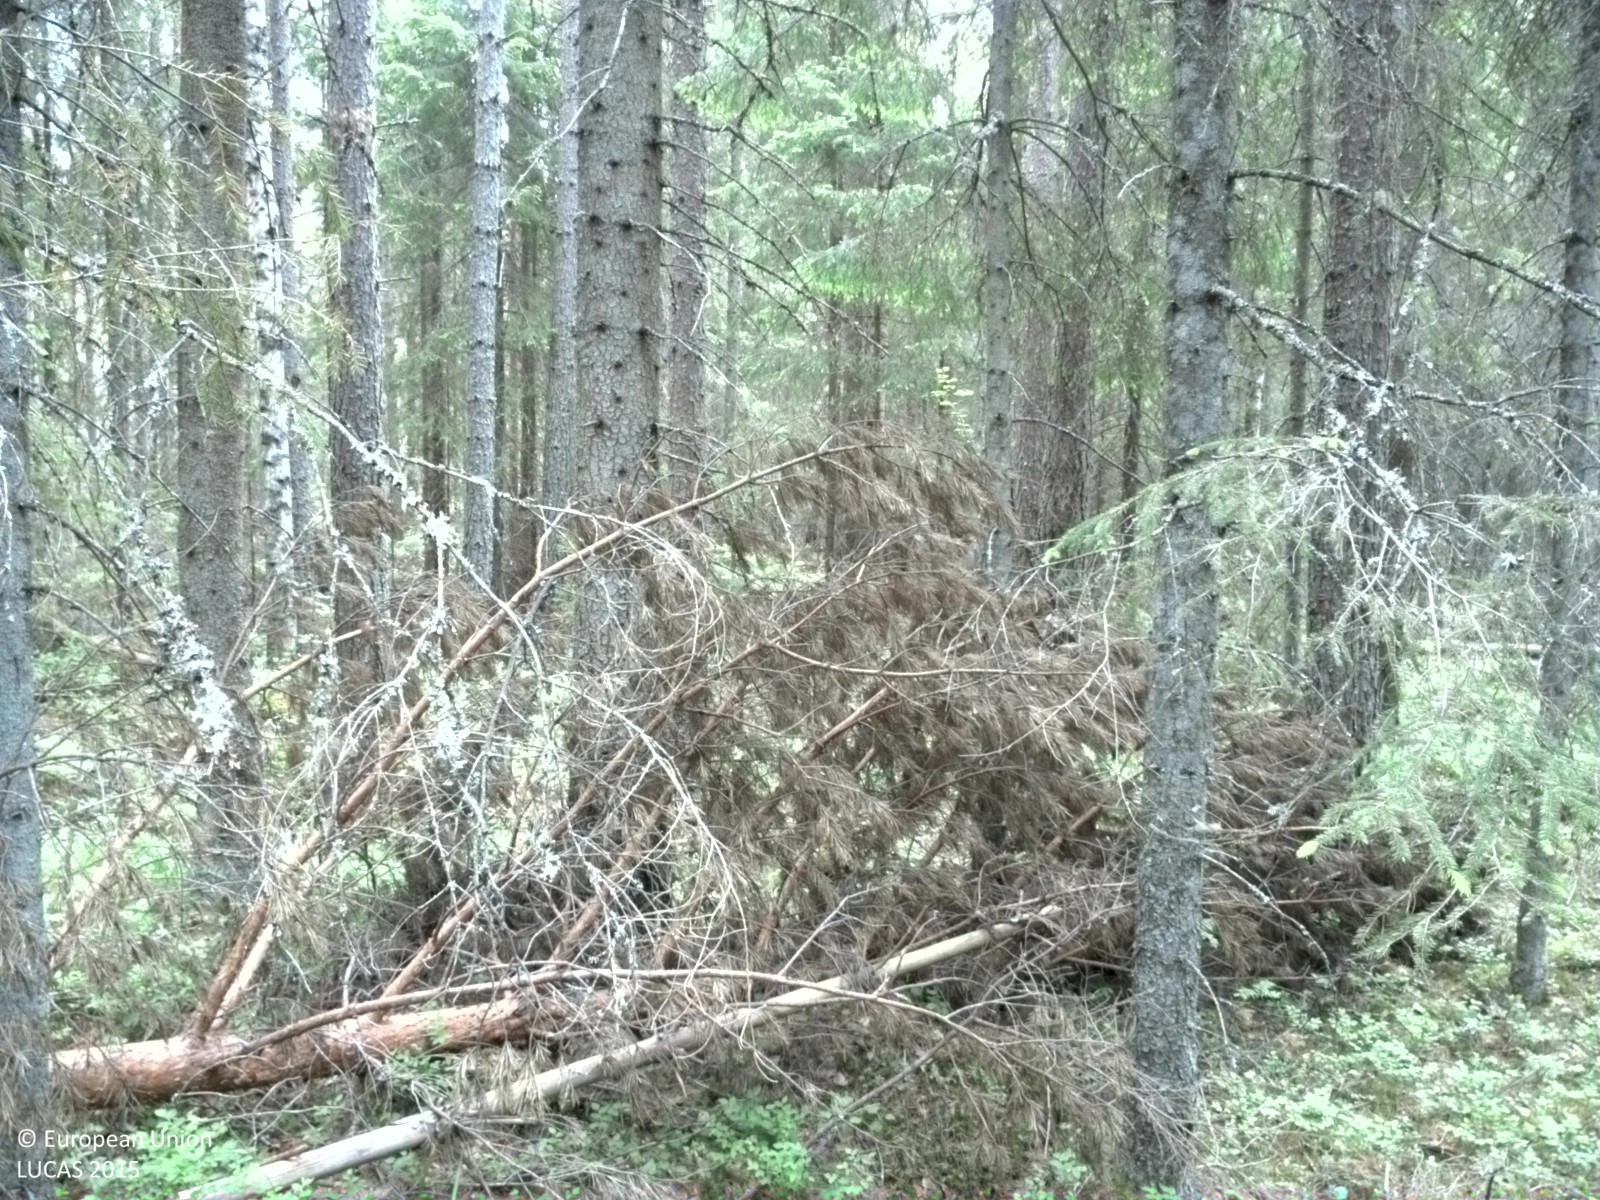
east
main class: Woodland
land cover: Spruce dominated coniferous woodland
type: boreal forest
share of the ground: > 75 %
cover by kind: coniferous forest trees 75 %, shrubs 10 %, lichens and mosses 10 %, broadleaved forest trees 5 %
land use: Forestry
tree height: > 5 m
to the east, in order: Spruce dominated coniferous woodland; Other coniferous woodland; Pine dominated coniferous woodland; Pine dominated mixed woodland; Spruce dominated coniferous woodland; Pine dominated mixed woodland; Pine dominated coniferous woodland
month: June
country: SE
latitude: 60.2642
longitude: 17.2753
